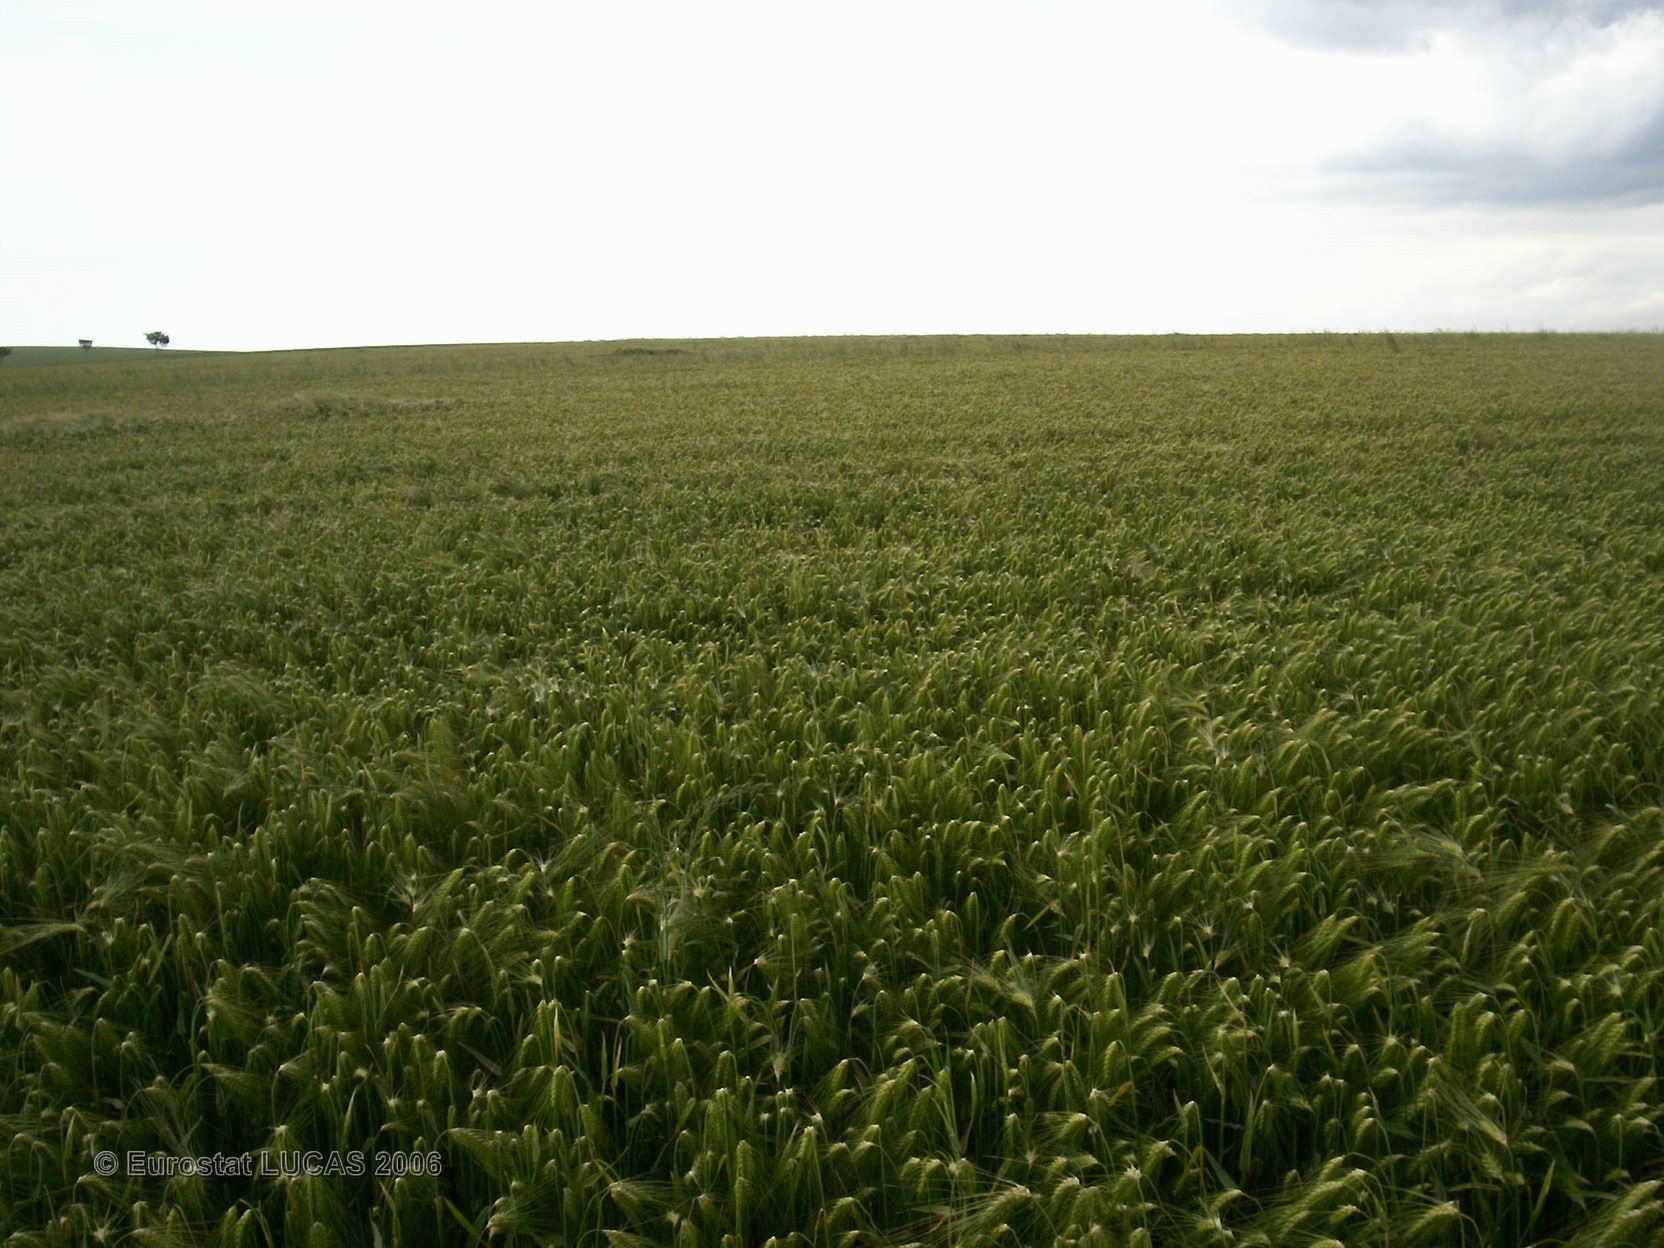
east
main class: Cropland
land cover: Barley
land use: Agriculture (excluding fallow land and kitchen gardens)
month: June
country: FR
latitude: 48.6068
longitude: 4.4500
